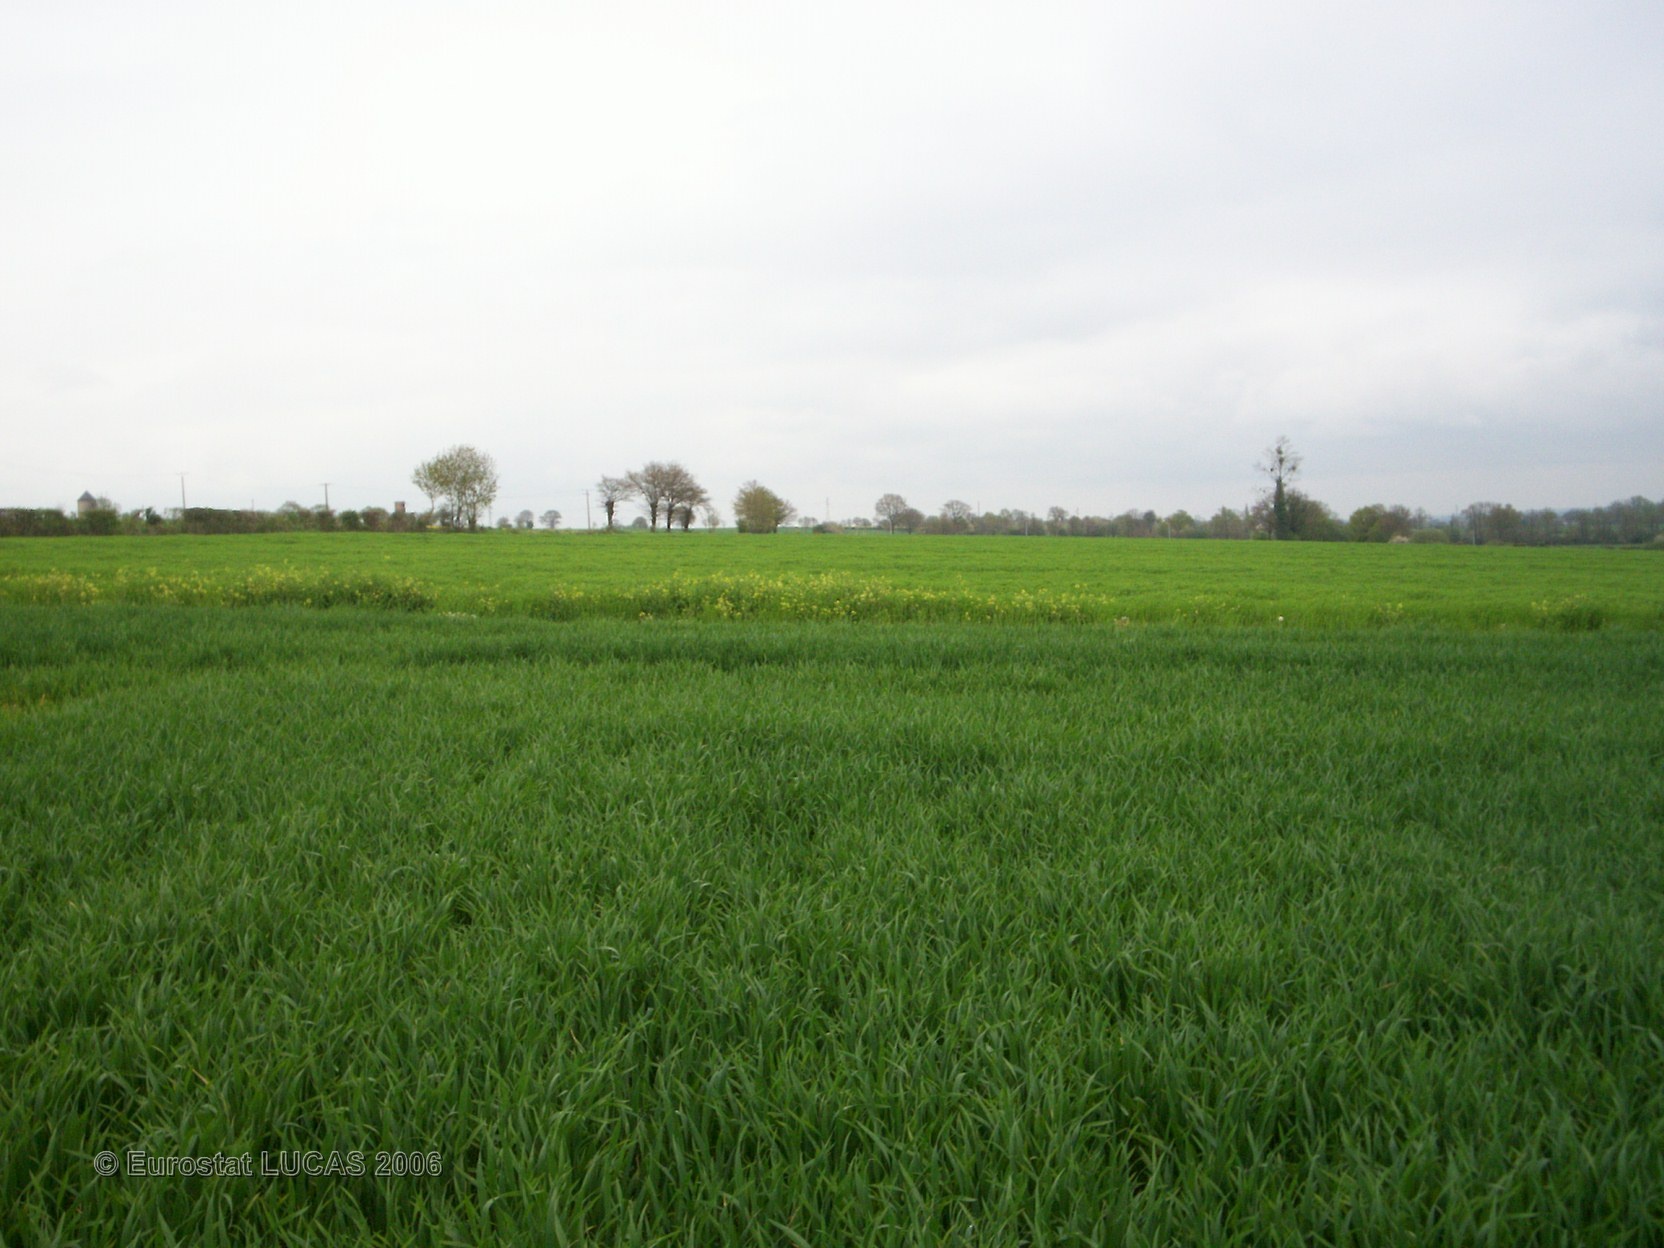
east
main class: Cropland
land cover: Common wheat
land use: Agriculture (excluding fallow land and kitchen gardens)
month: April
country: FR
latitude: 47.8680
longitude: -1.5557
